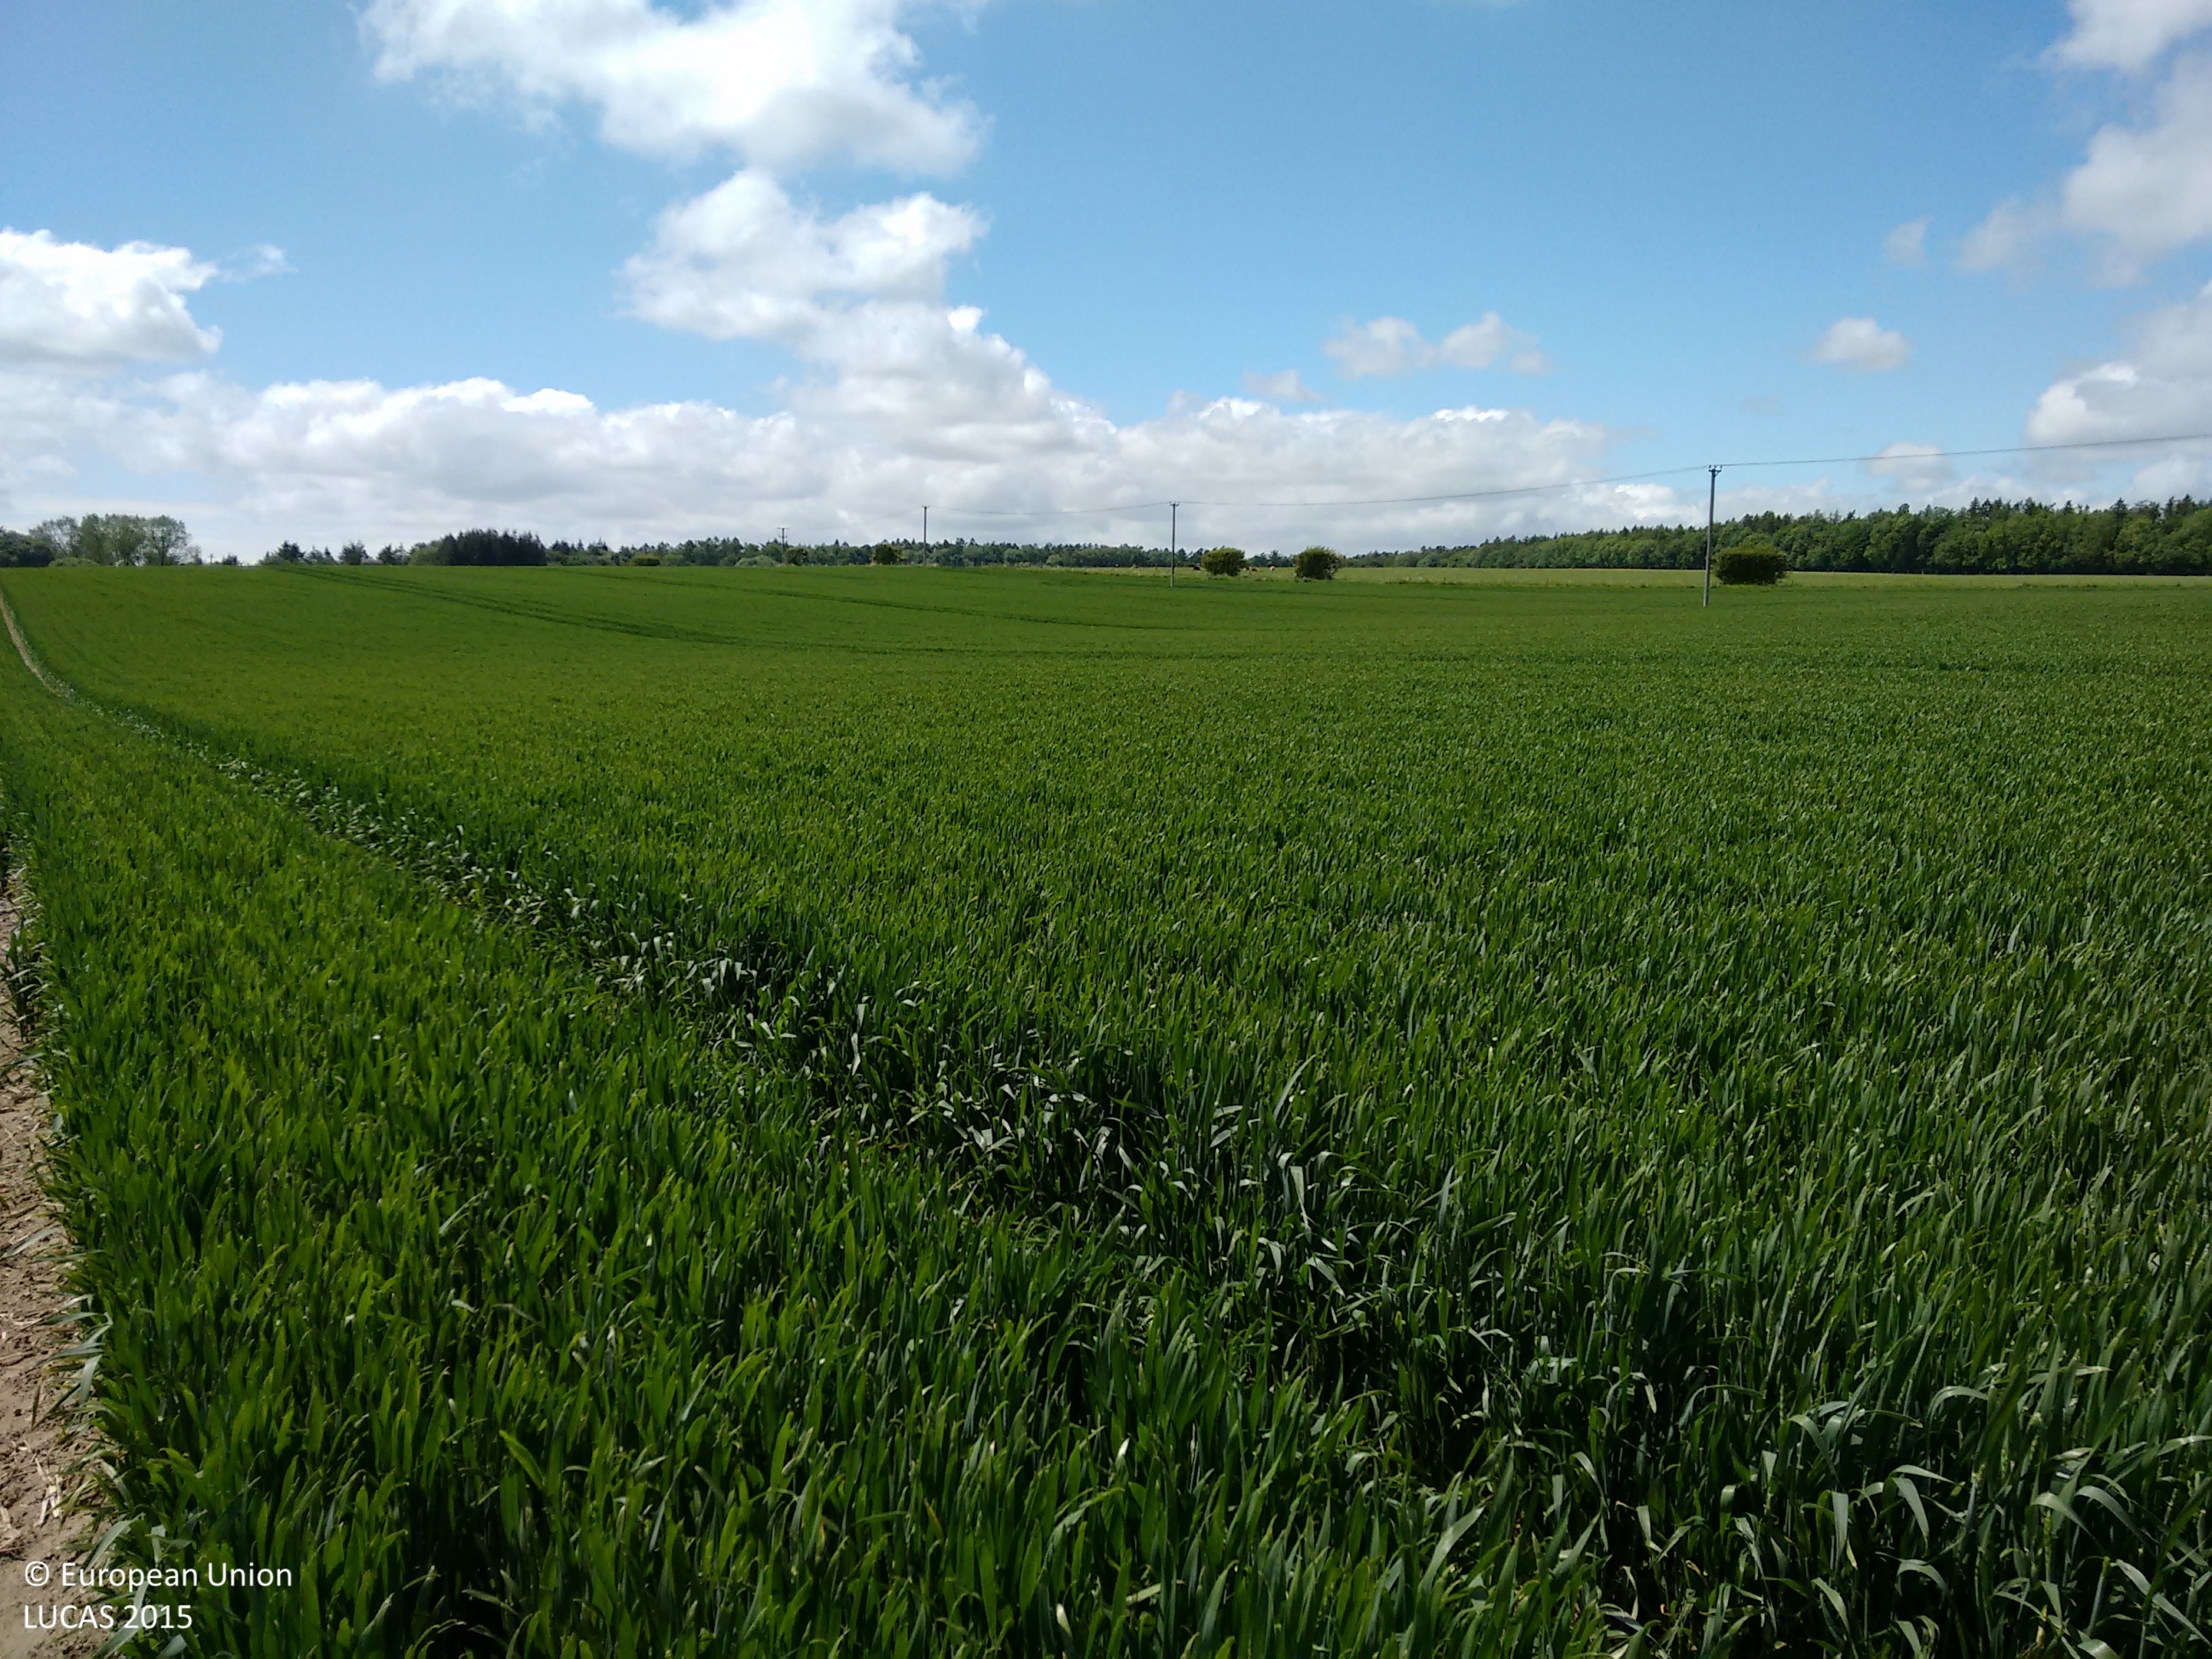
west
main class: Cropland
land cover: Common wheat
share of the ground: > 75 %
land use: Agriculture (excluding fallow land and kitchen gardens)
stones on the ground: < 10 %
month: June
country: GB
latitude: 51.0304
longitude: -2.0800
